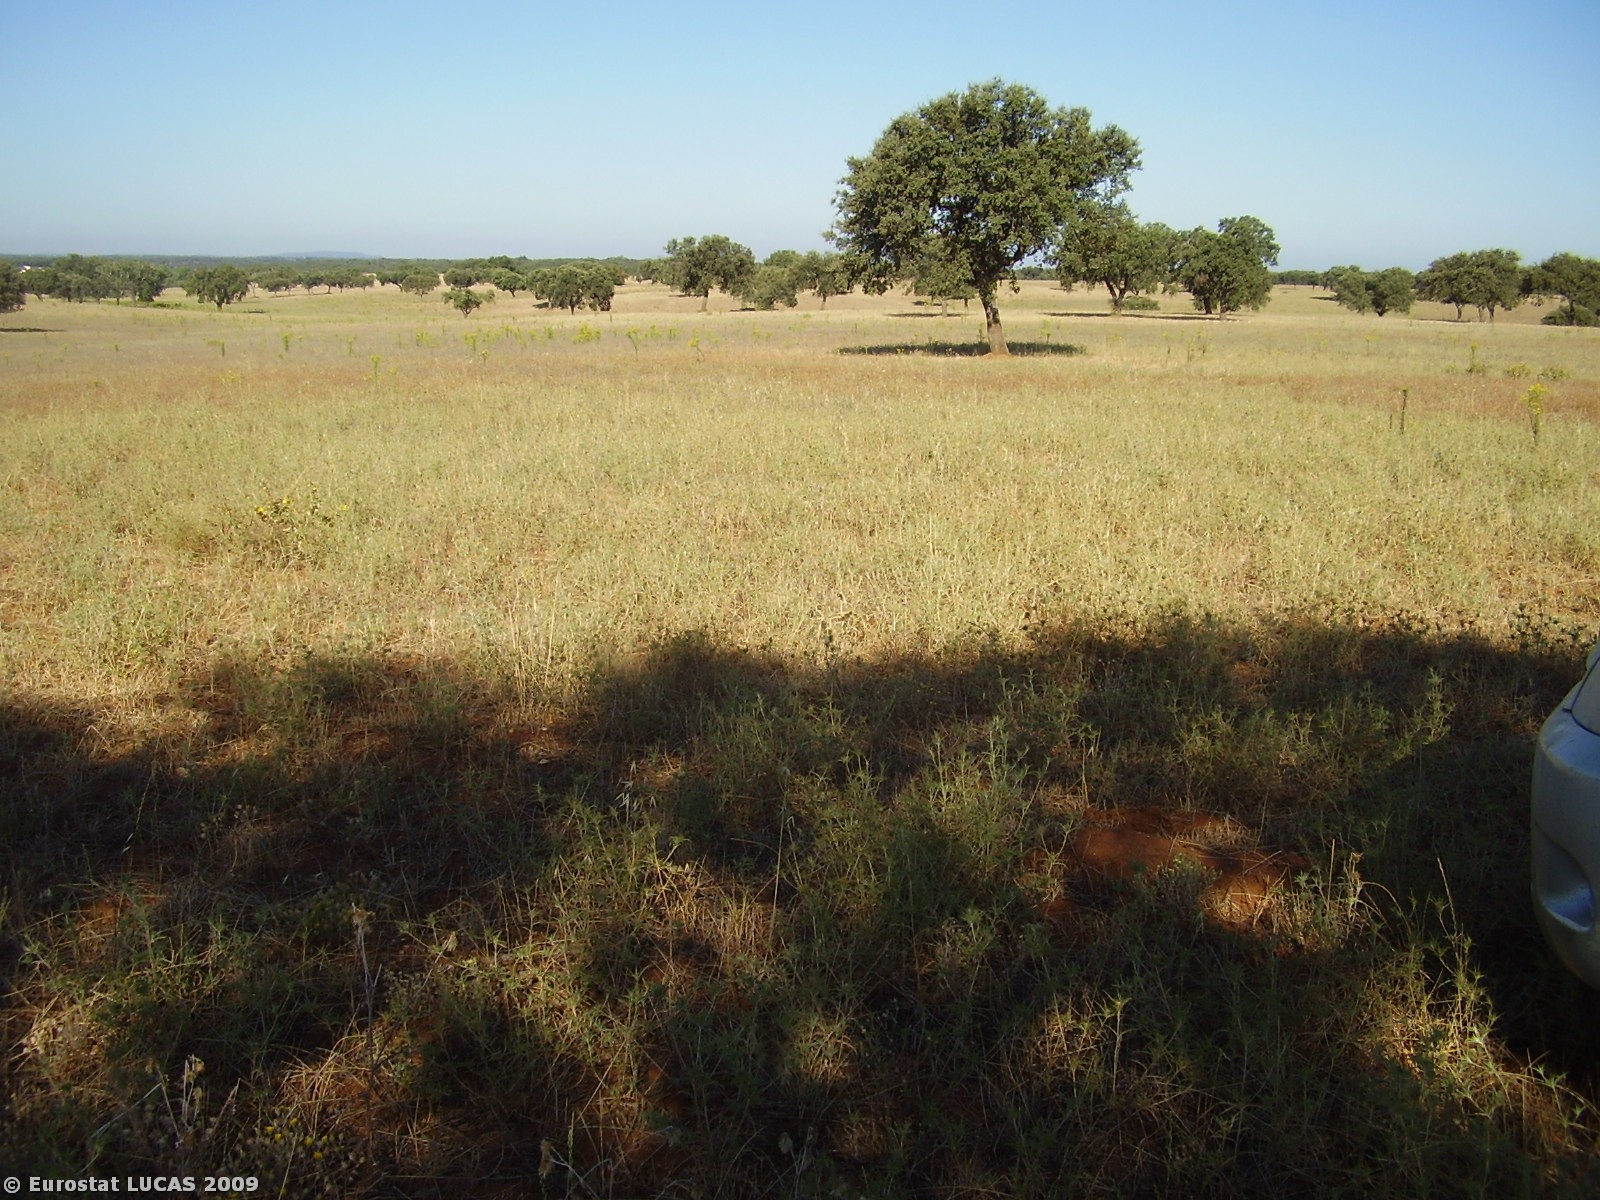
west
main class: Grassland
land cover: Grassland with sparse tree/shrub cover
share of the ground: > 75 %
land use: Fallow land
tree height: > 5 m
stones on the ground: 25 - 50 %
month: July
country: PT
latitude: 38.8772
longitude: -7.7347
